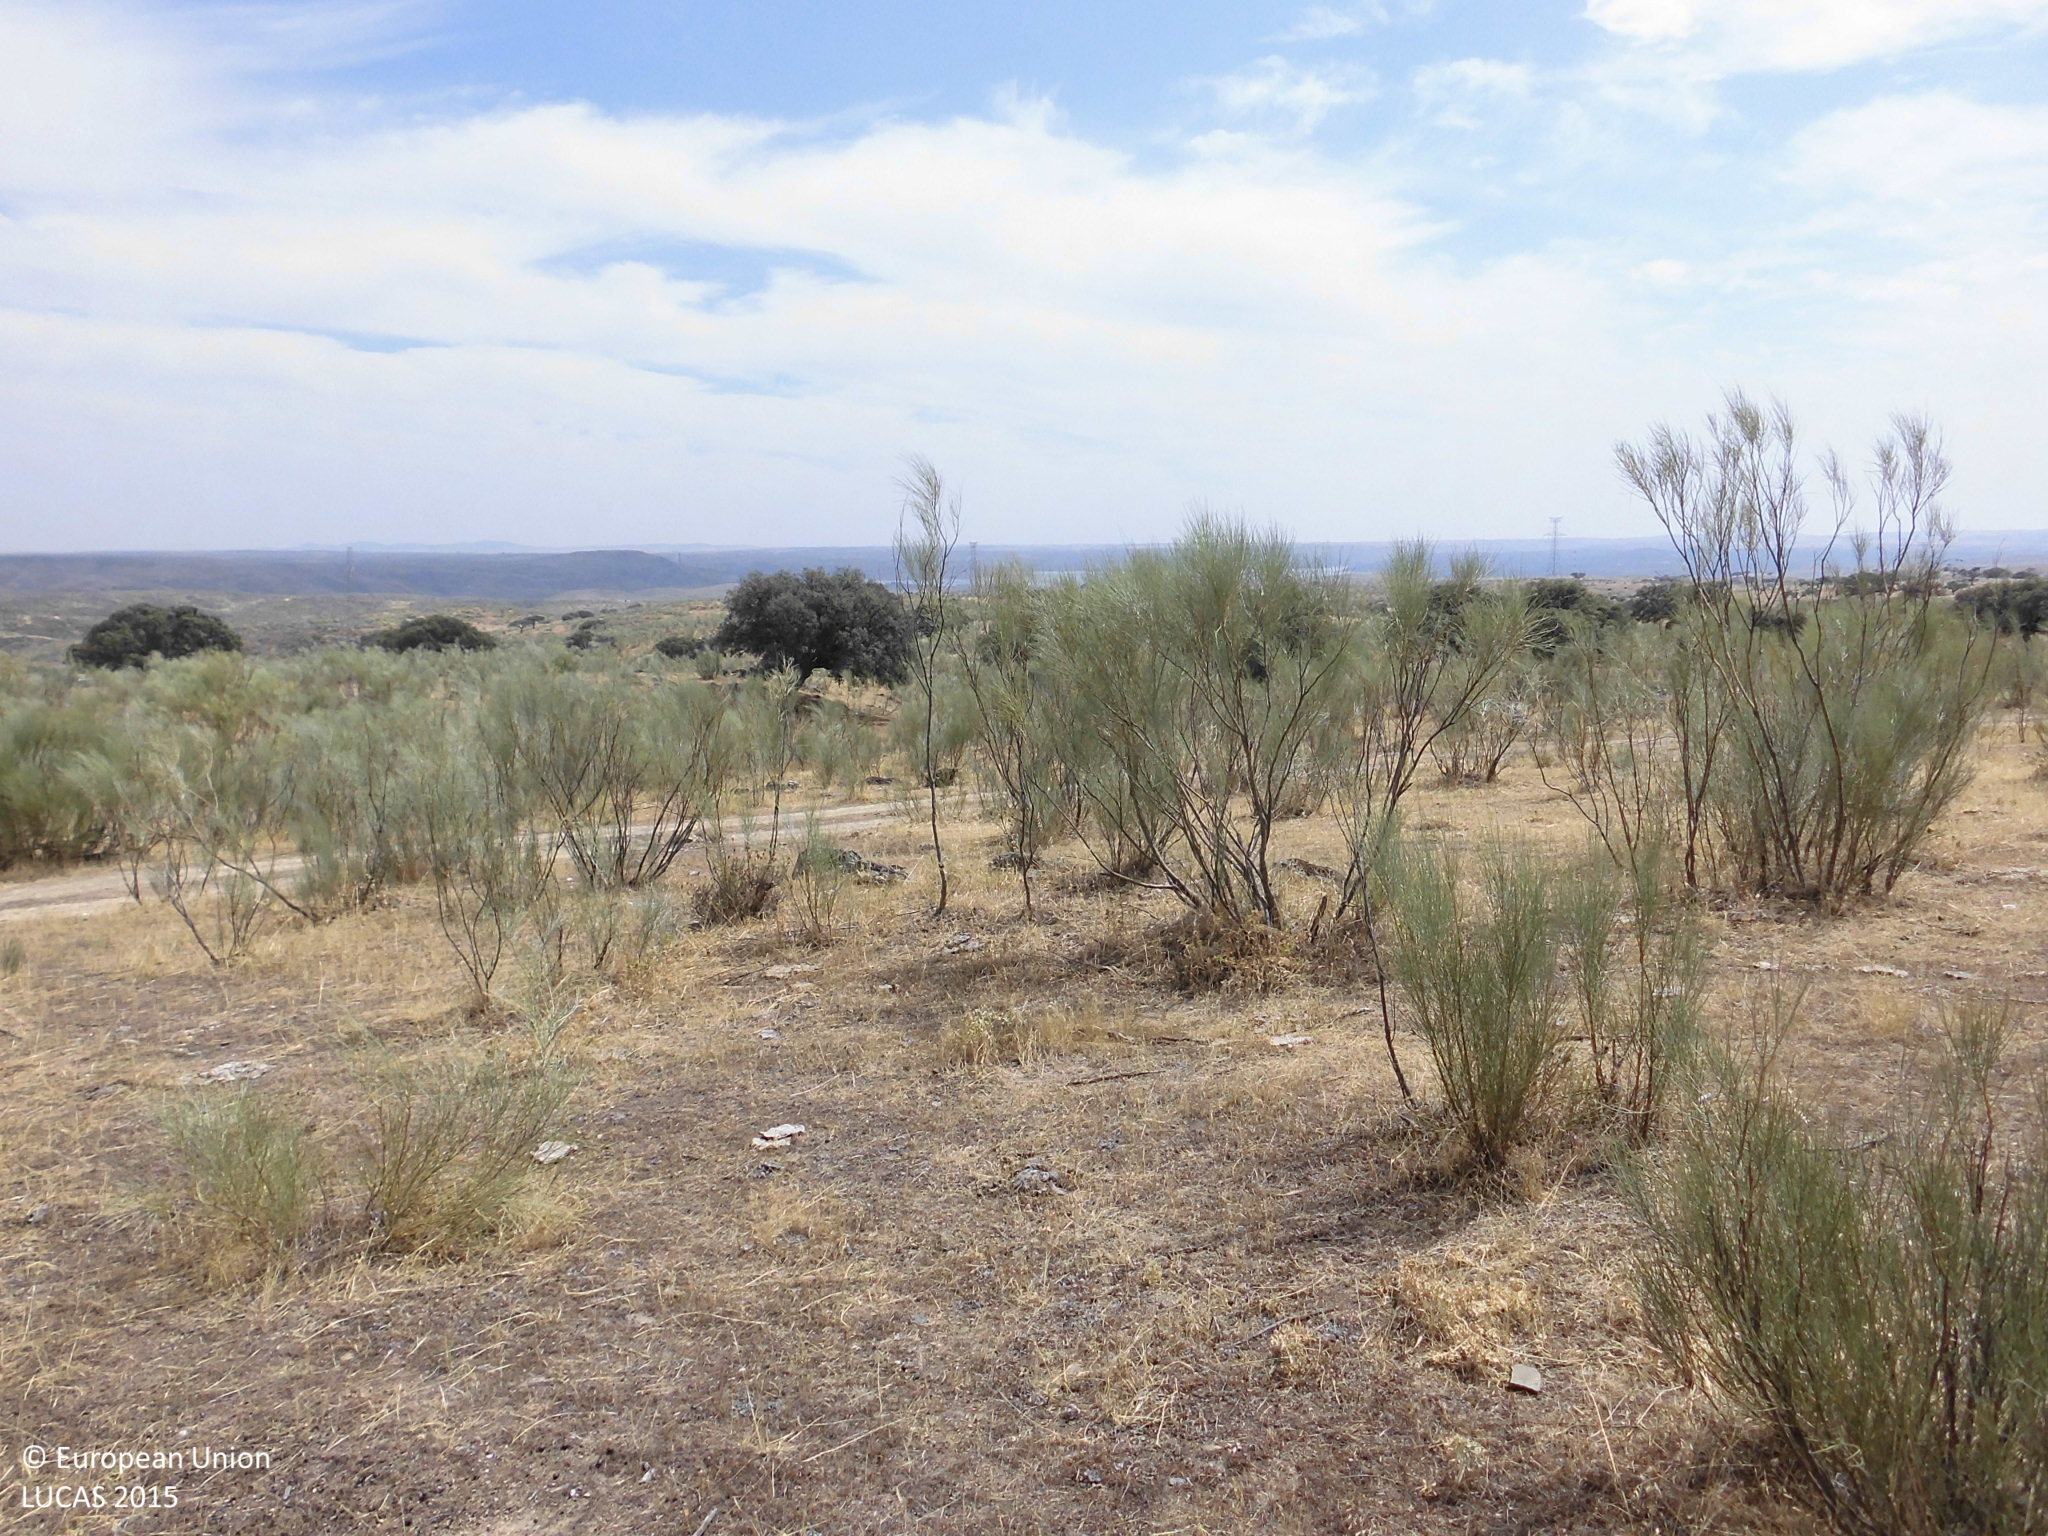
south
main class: Shrubland
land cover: Shrubland without tree cover
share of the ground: 10 - 25 %
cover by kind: herbaceous plants 85 %, shrubs 15 %
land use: Agriculture (excluding fallow land and kitchen gardens)
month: July
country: ES
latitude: 39.7876
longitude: -6.4581
